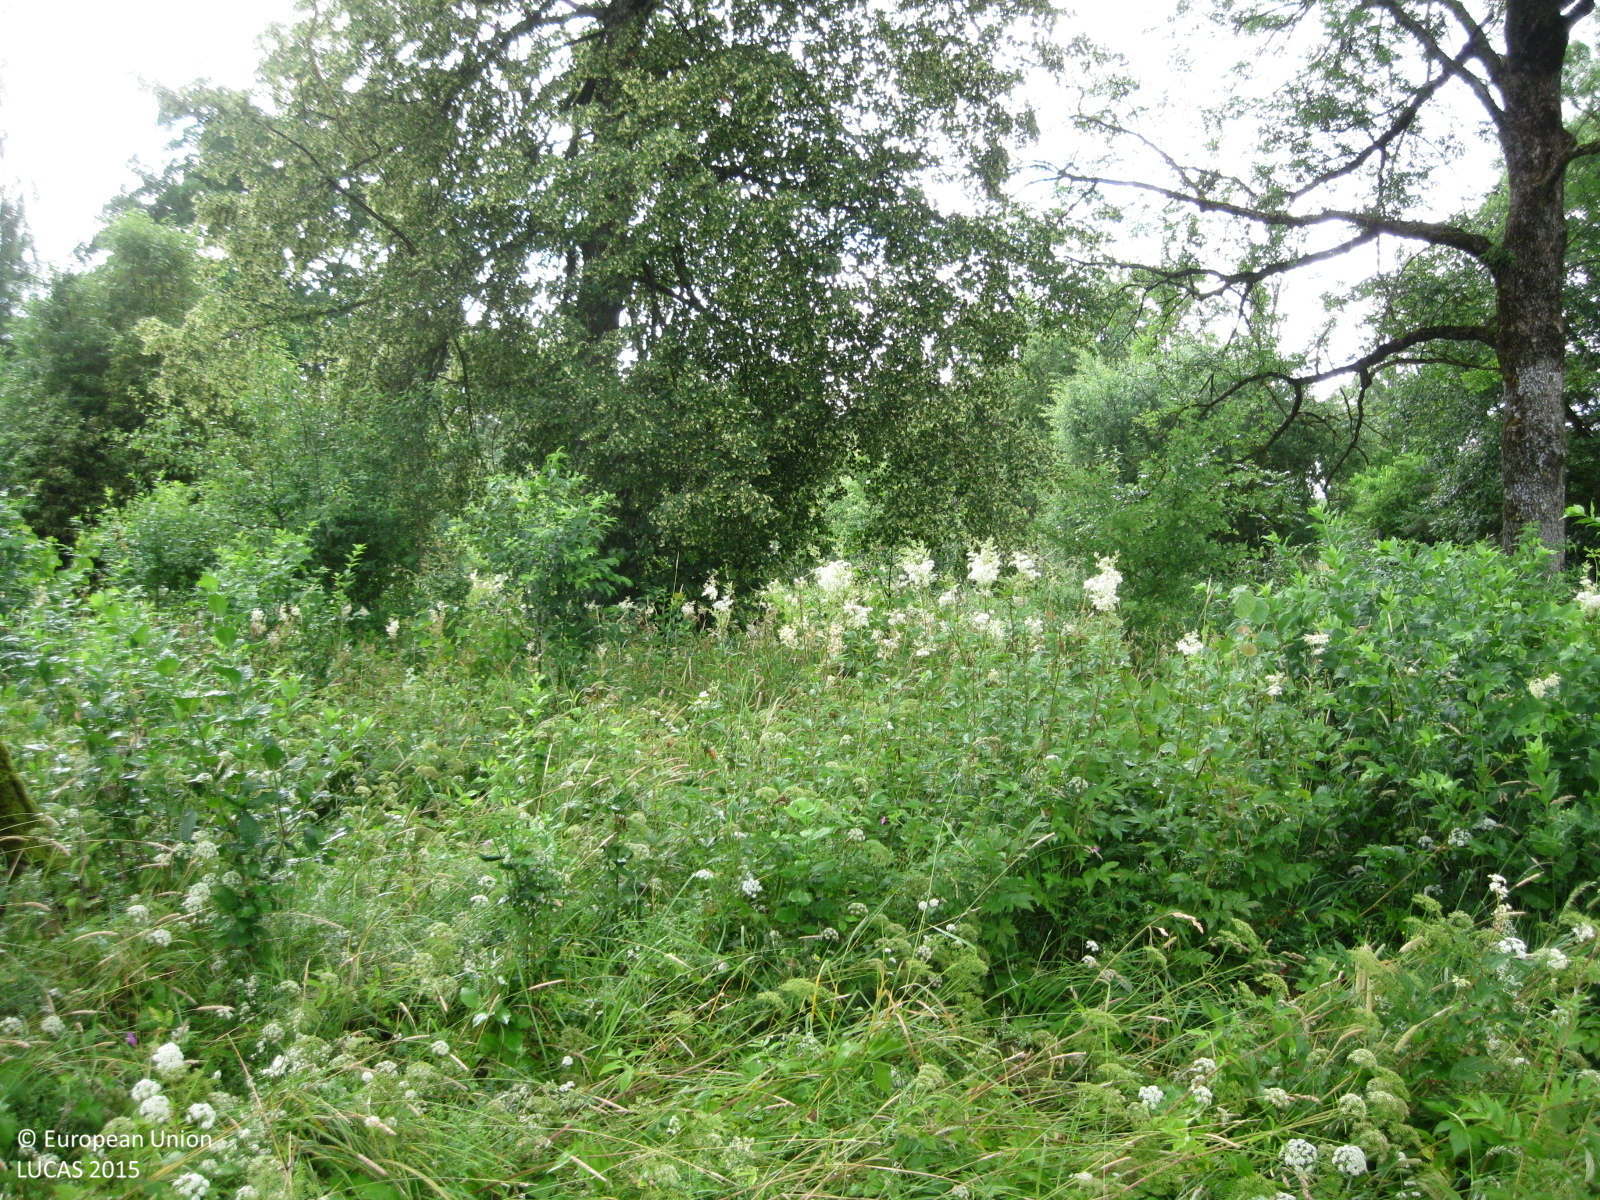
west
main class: Grassland
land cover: Spontaneously vegetated surfaces
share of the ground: > 75 %
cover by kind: herbaceous plants 100 %
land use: Fallow land
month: July
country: LT
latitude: 55.7817
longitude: 24.7909
